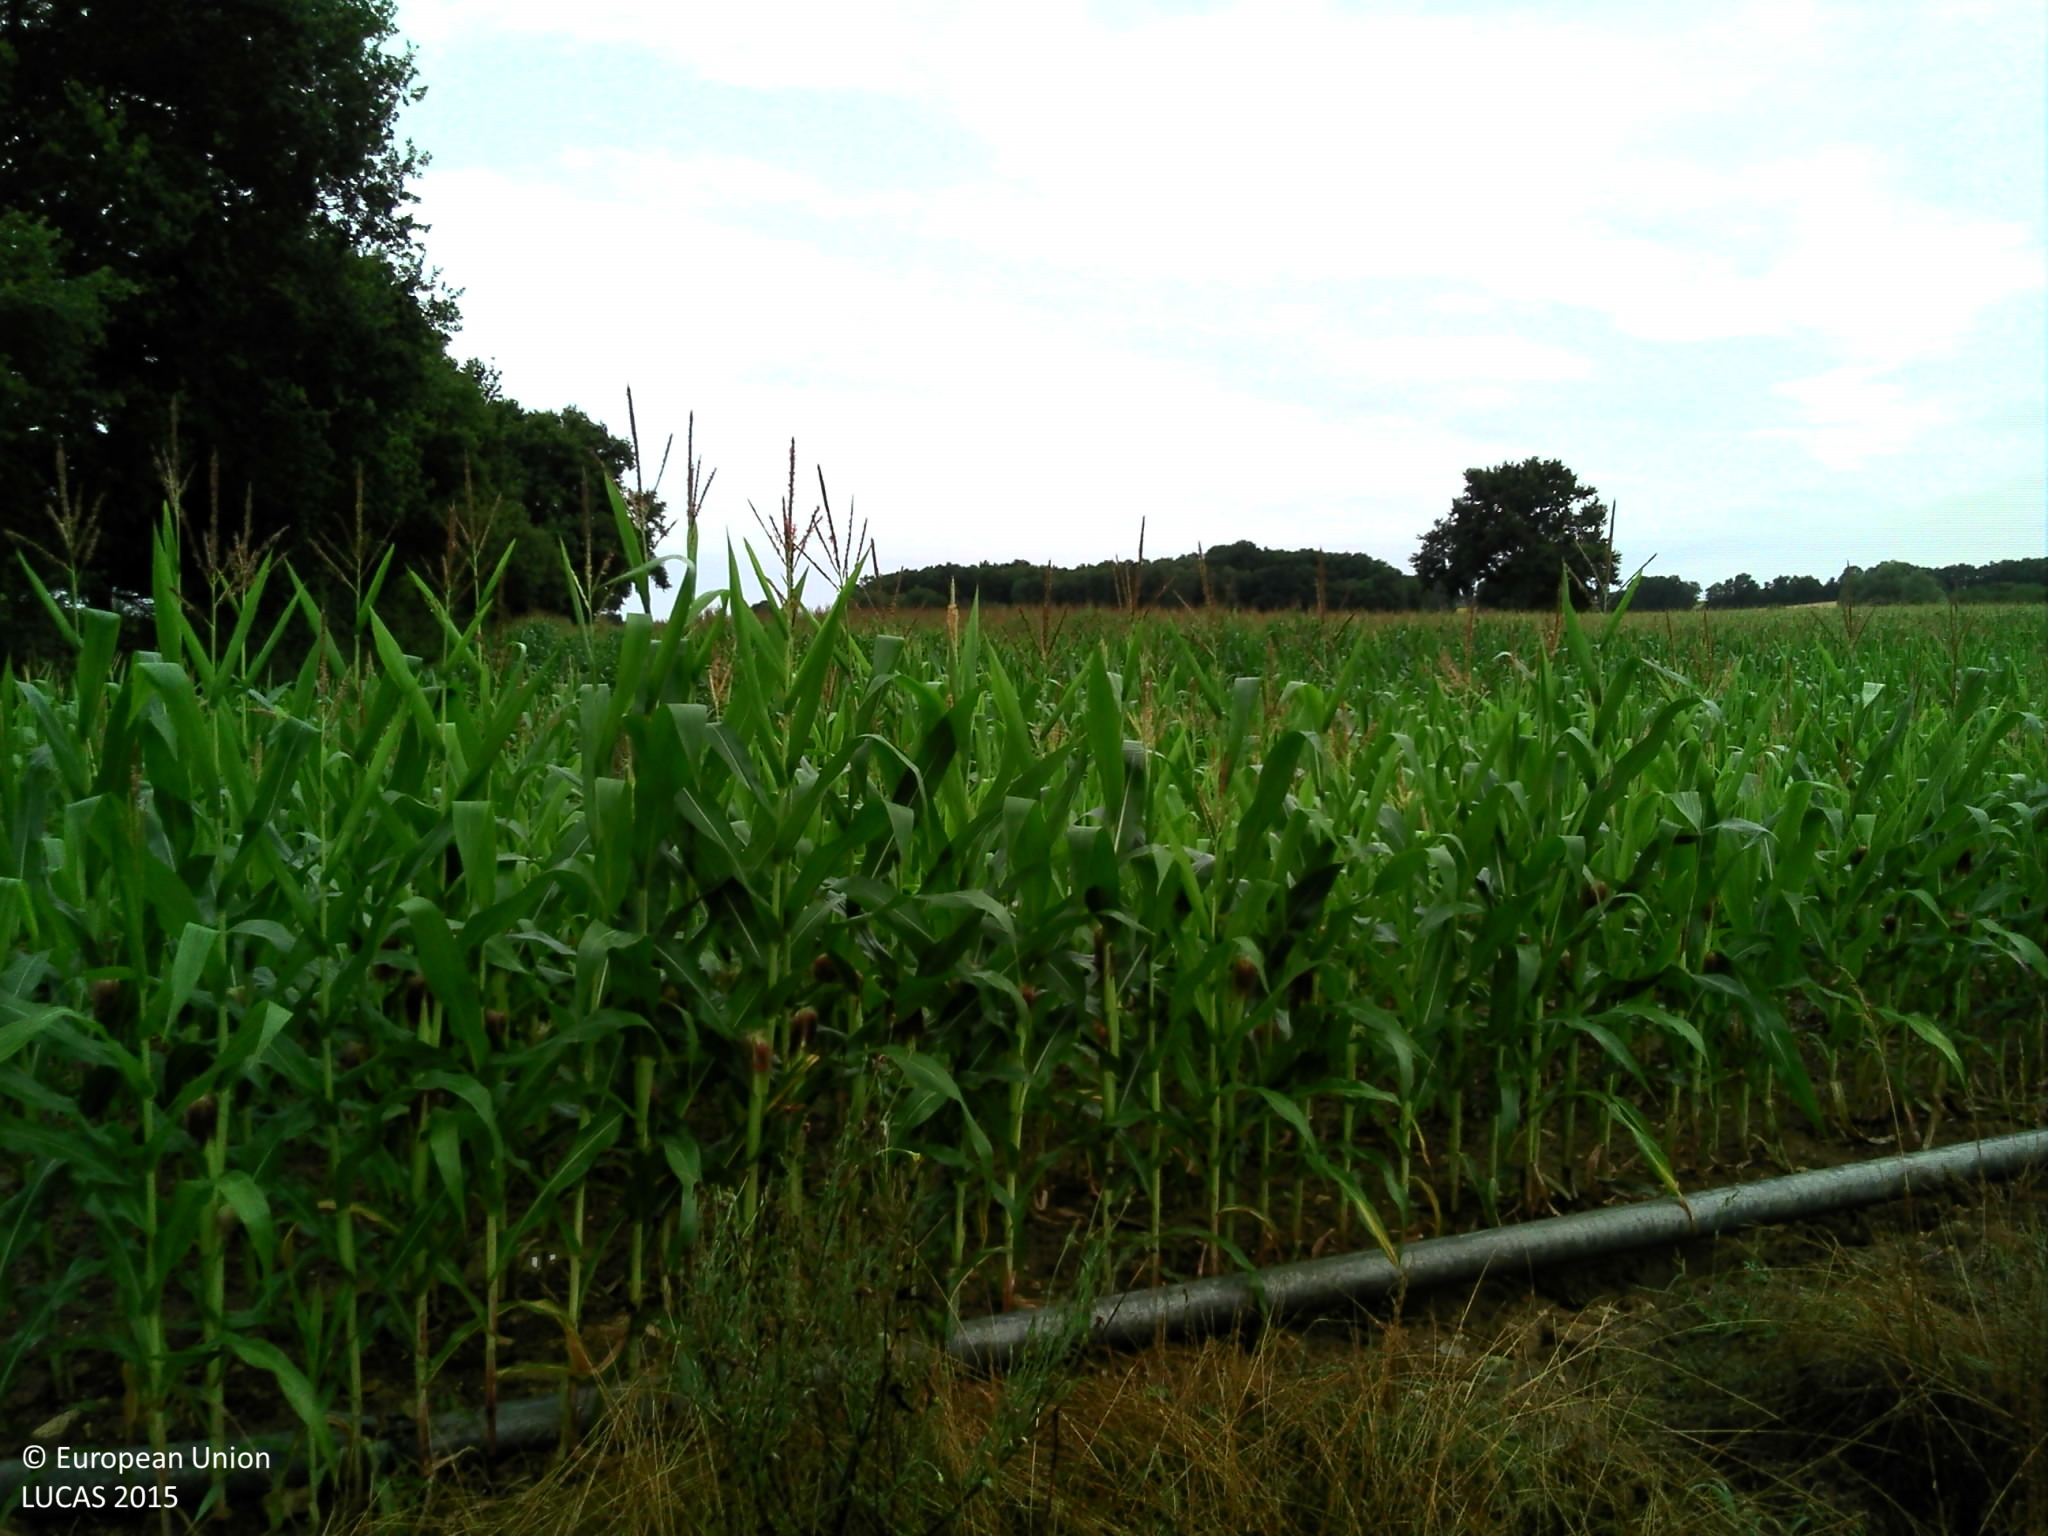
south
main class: Cropland
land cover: Maize
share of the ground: > 75 %
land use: Agriculture (excluding fallow land and kitchen gardens)
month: July
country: FR
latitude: 46.3679
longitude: 0.5594
